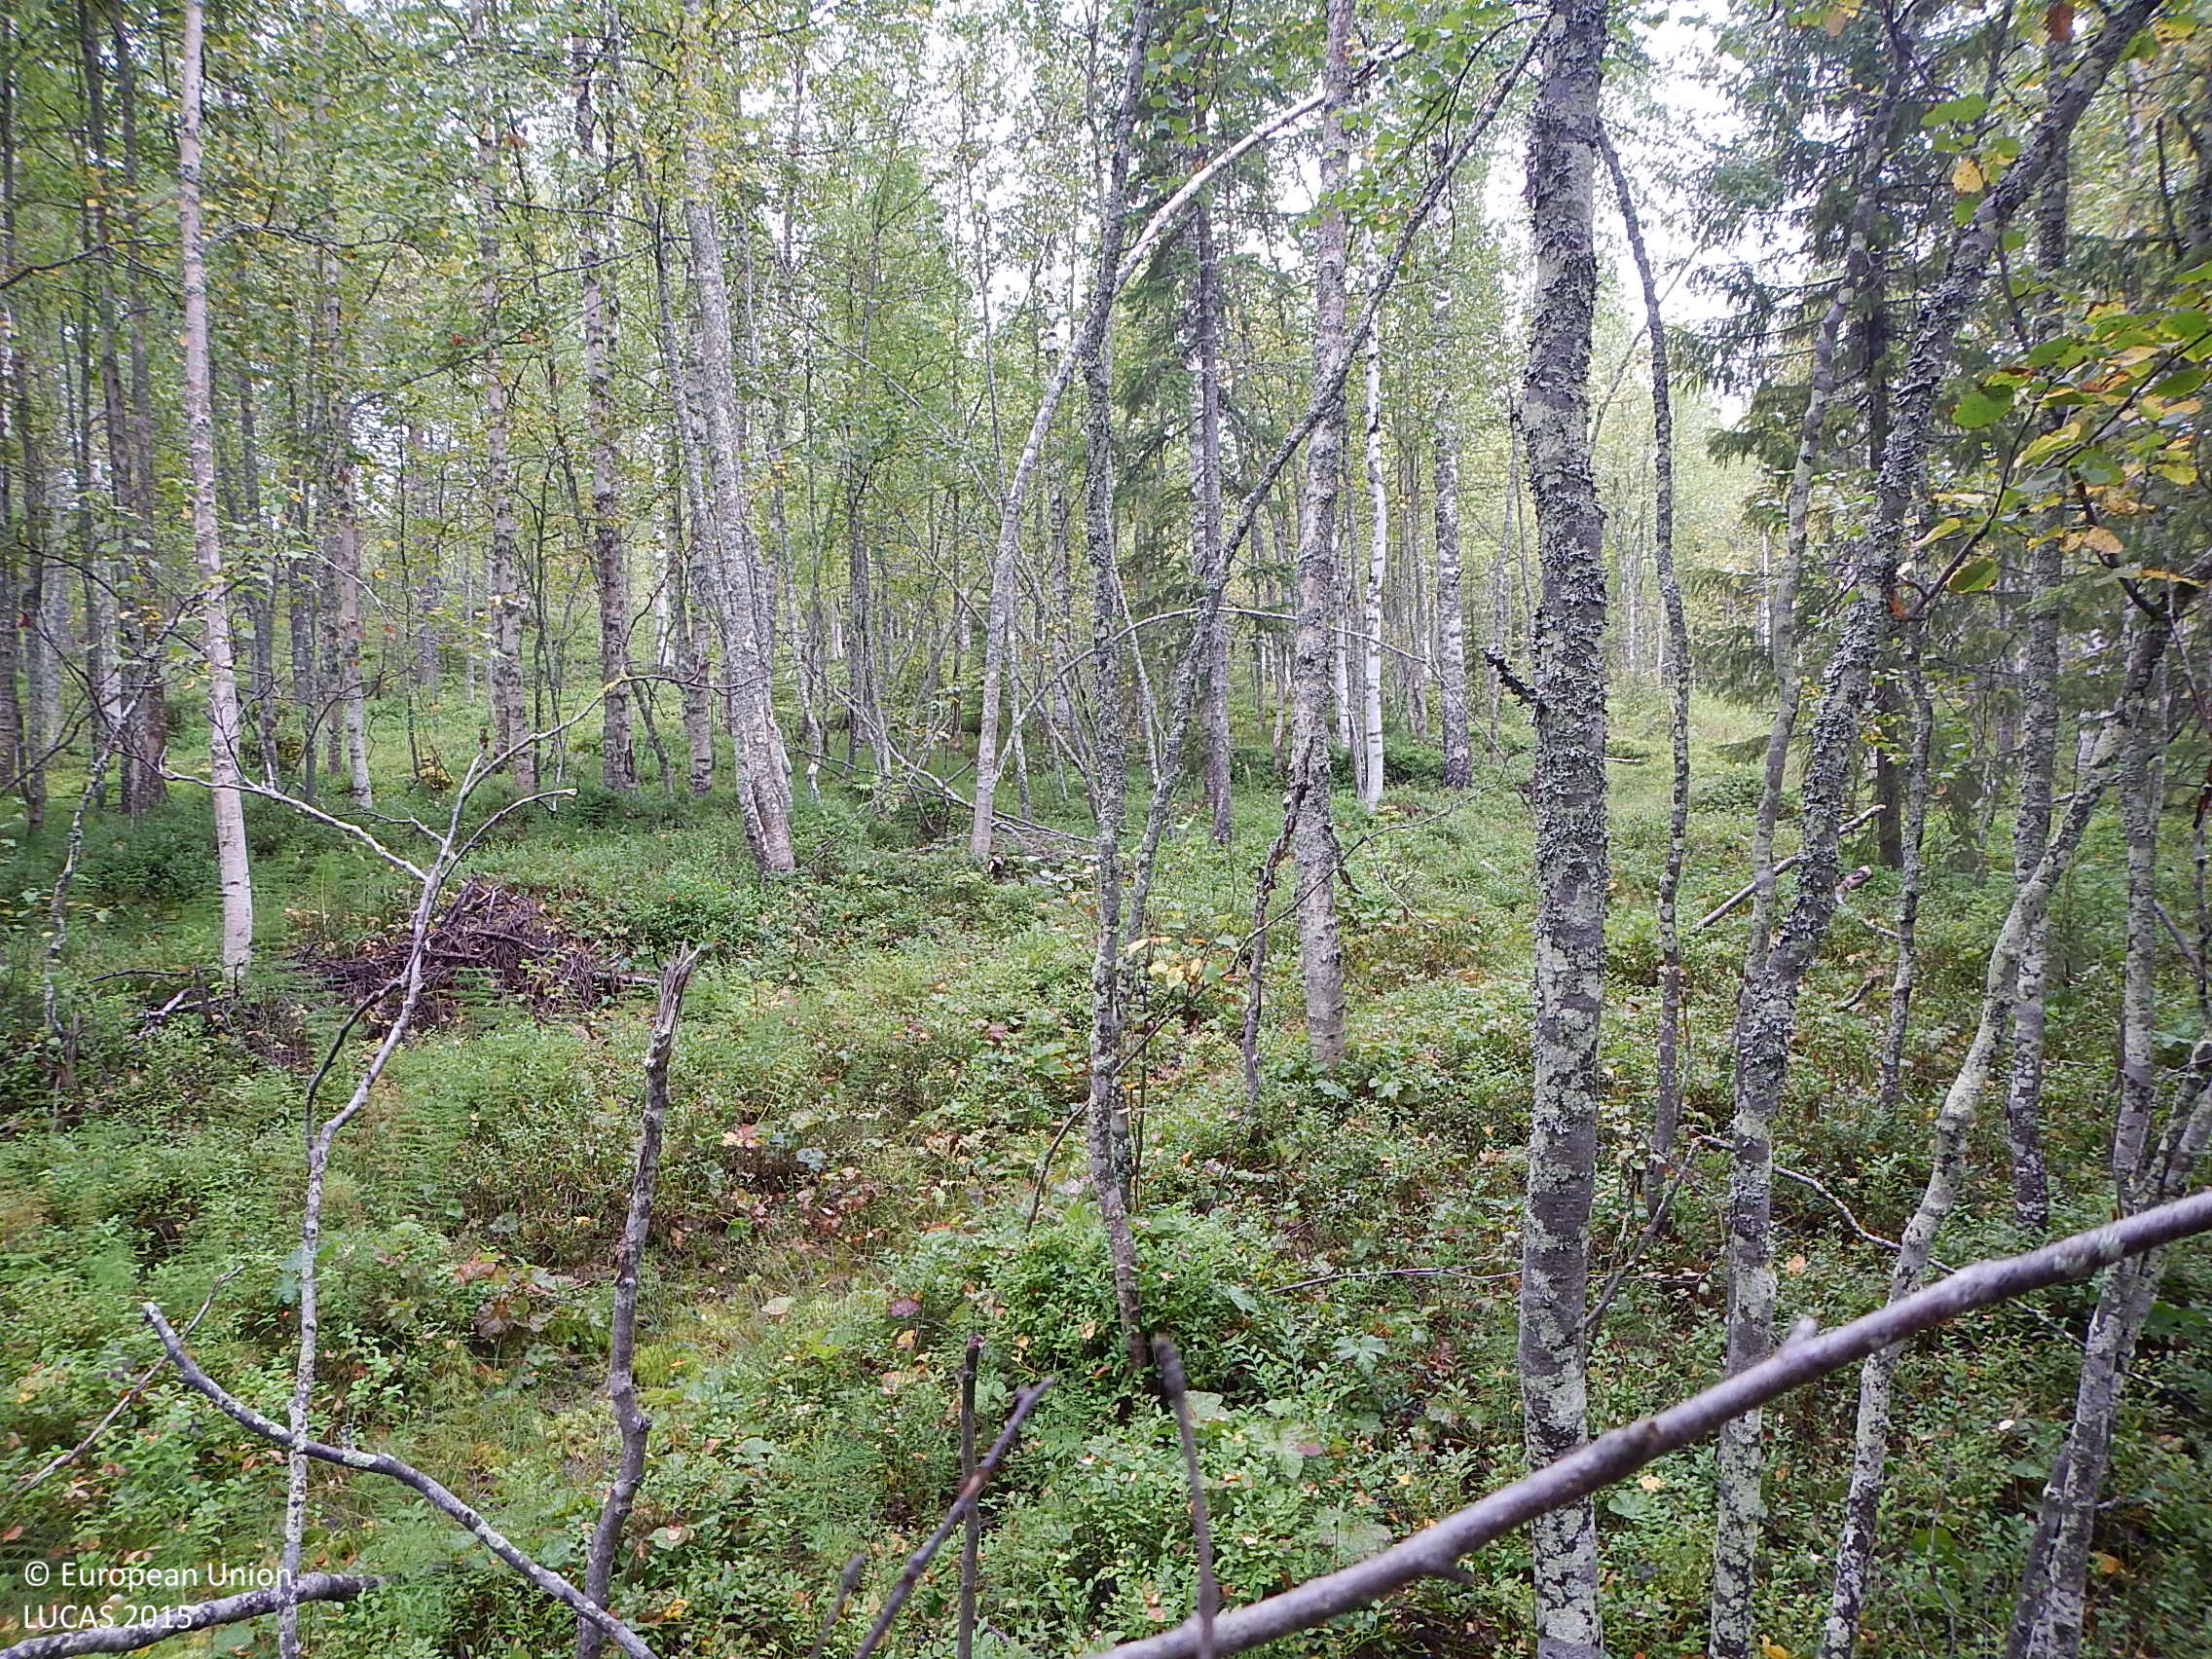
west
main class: Woodland
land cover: Spruce dominated mixed woodland
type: boreal forest
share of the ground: > 75 %
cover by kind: coniferous forest trees 55 %, broadleaved forest trees 30 %, shrubs 15 %
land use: Forestry
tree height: > 5 m
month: August
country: FI
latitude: 65.9071
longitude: 26.9910
